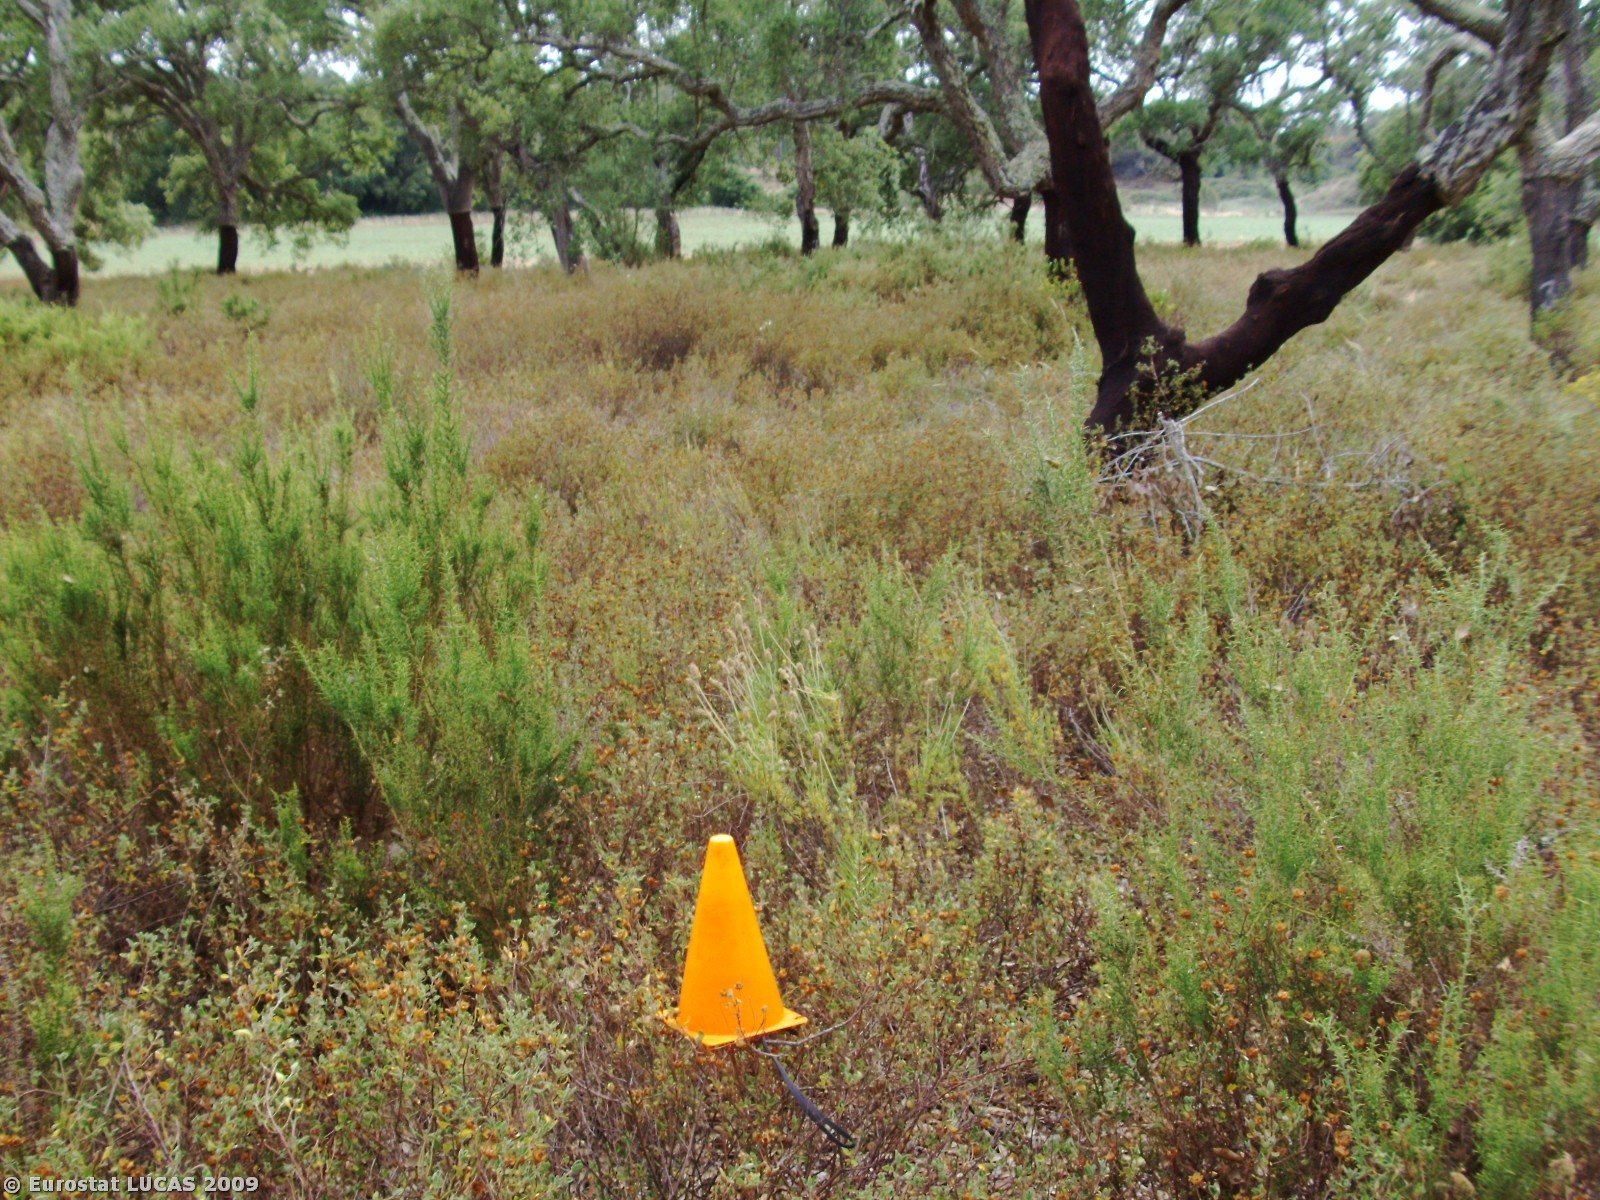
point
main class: Woodland
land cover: Broadleaved woodland
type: broadleaved evergreen forest
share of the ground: 10 - 25 %
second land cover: Shrubland with sparse tree cover
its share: 50 - 75 %
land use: Forestry
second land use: Unused
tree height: > 5 m
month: June
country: PT
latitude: 38.0564
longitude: -8.7293
